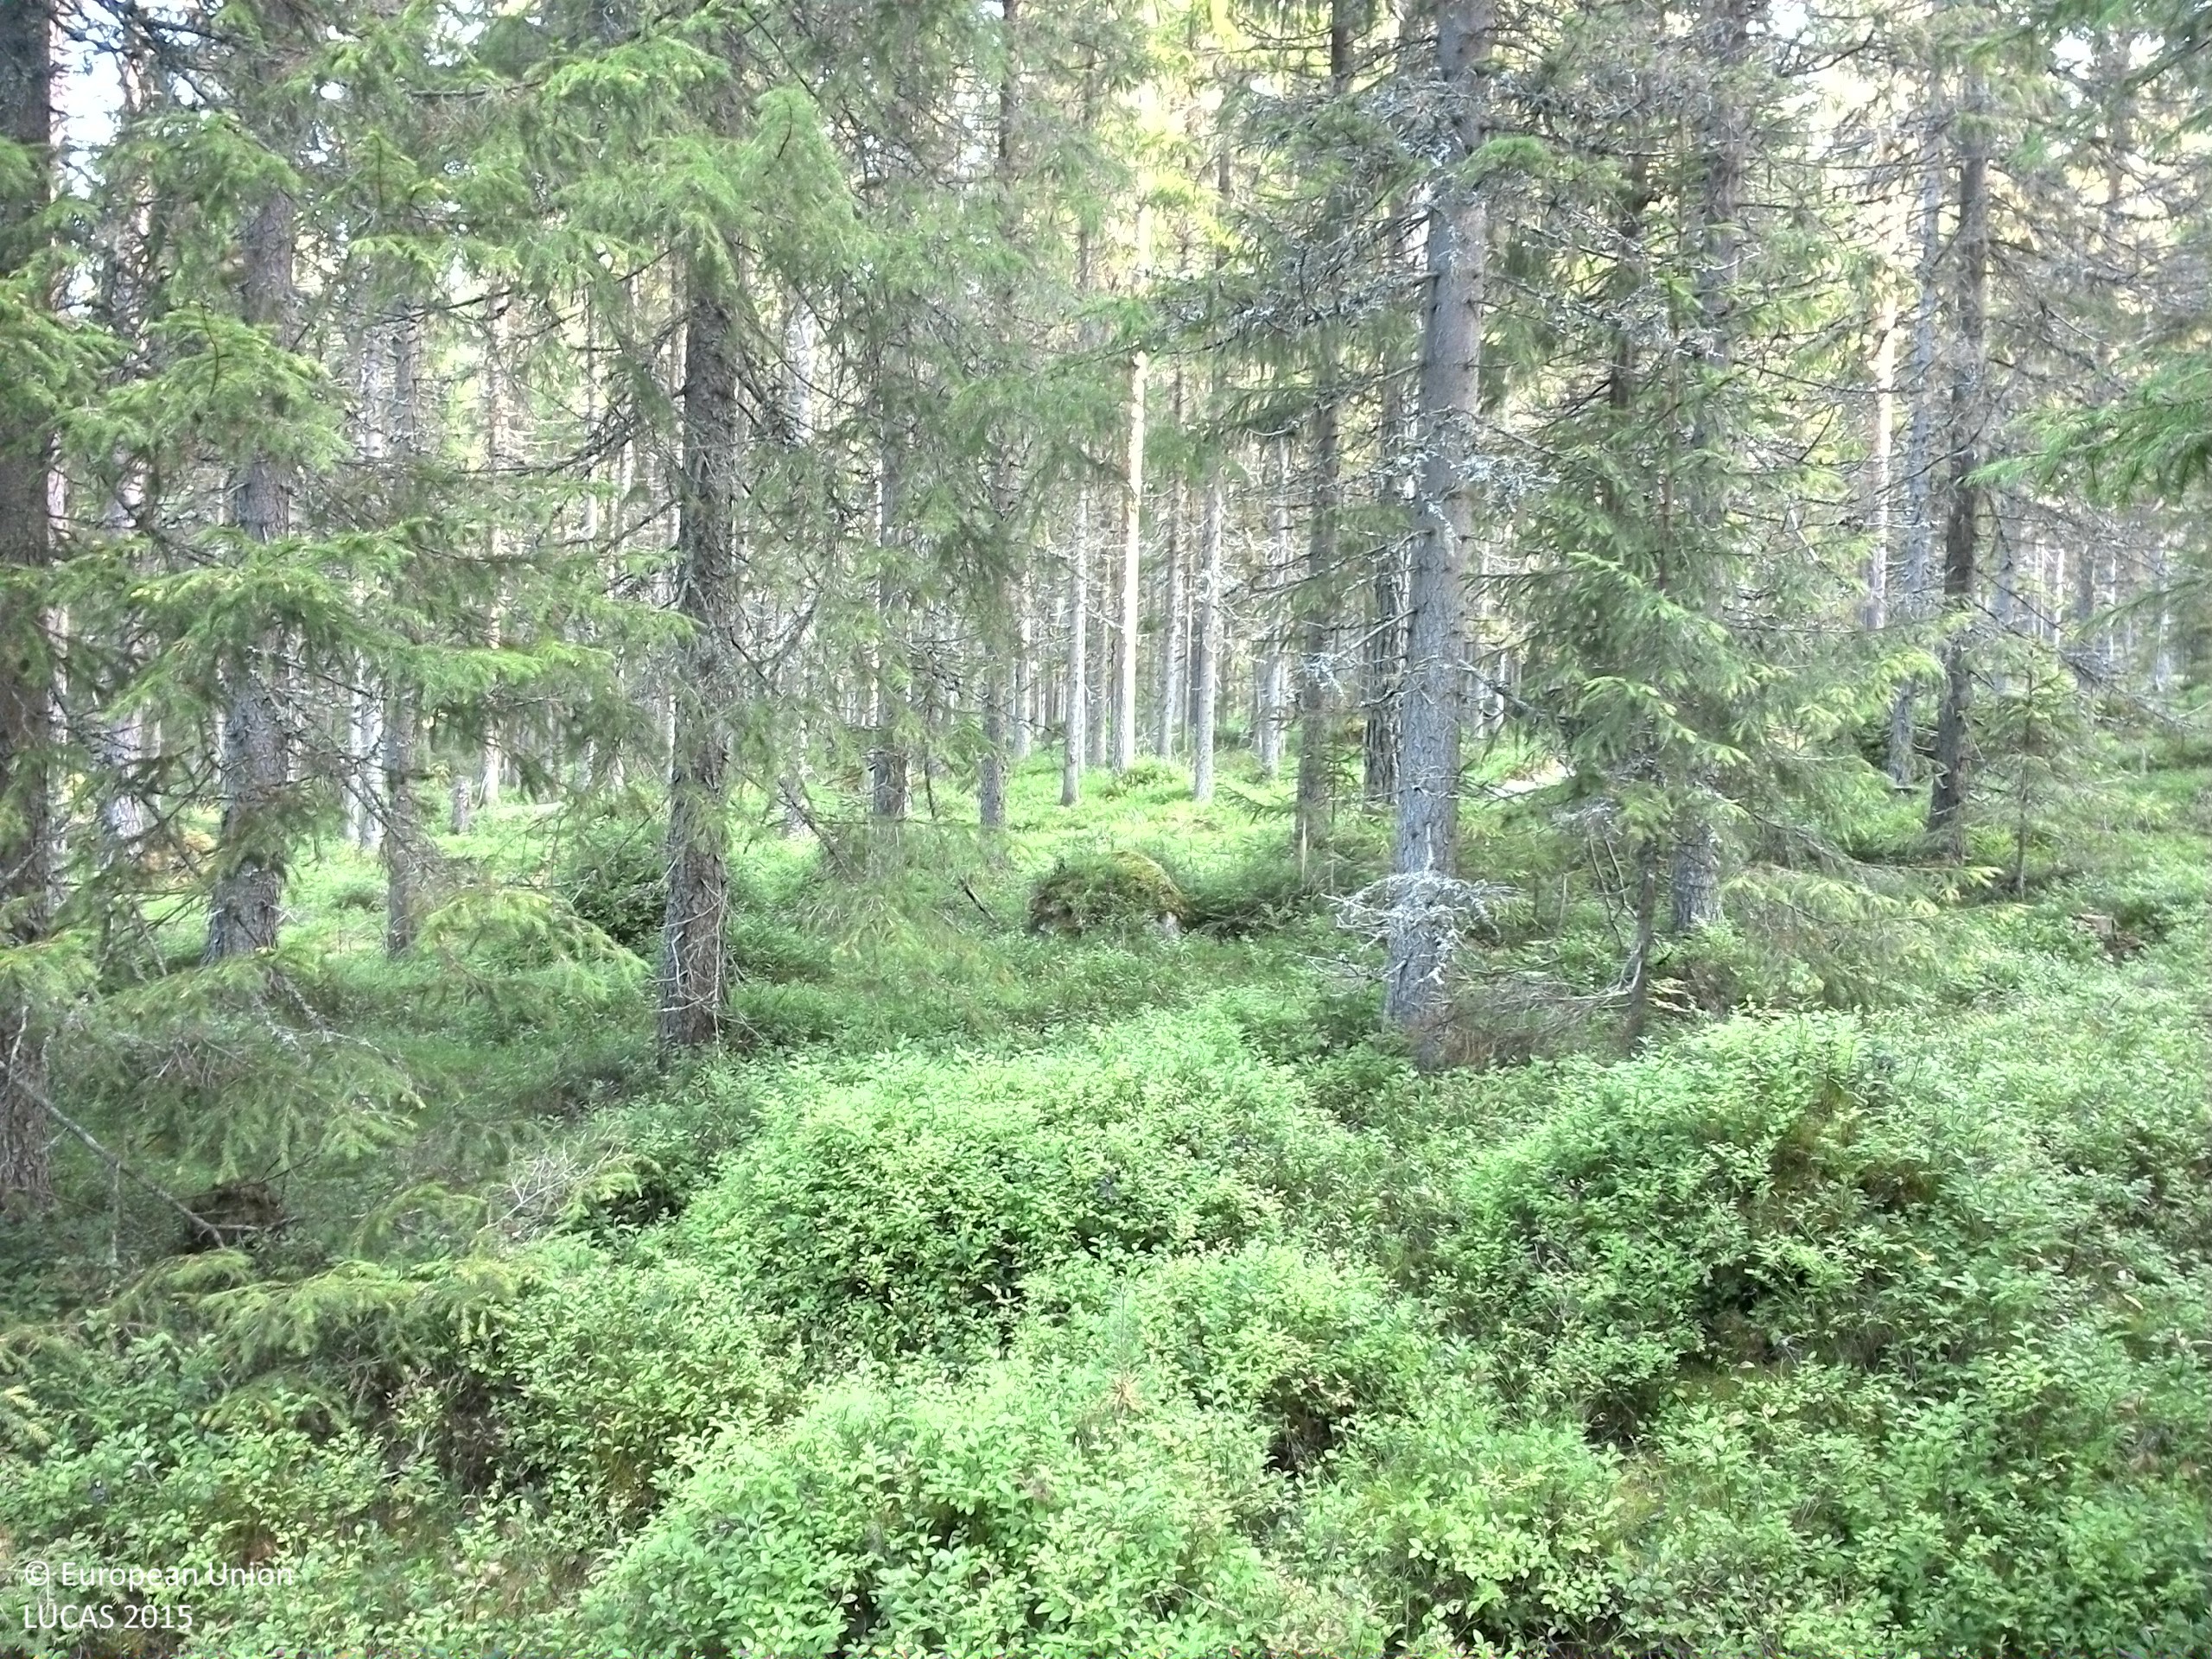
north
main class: Woodland
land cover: Spruce dominated coniferous woodland
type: boreal forest
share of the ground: 50 - 75 %
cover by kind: coniferous forest trees 55 %, shrubs 25 %, lichens and mosses 10 %, broadleaved forest trees 5 %, herbaceous plants 5 %
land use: Forestry
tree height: > 5 m
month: September
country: SE
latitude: 63.9525
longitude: 16.6047
